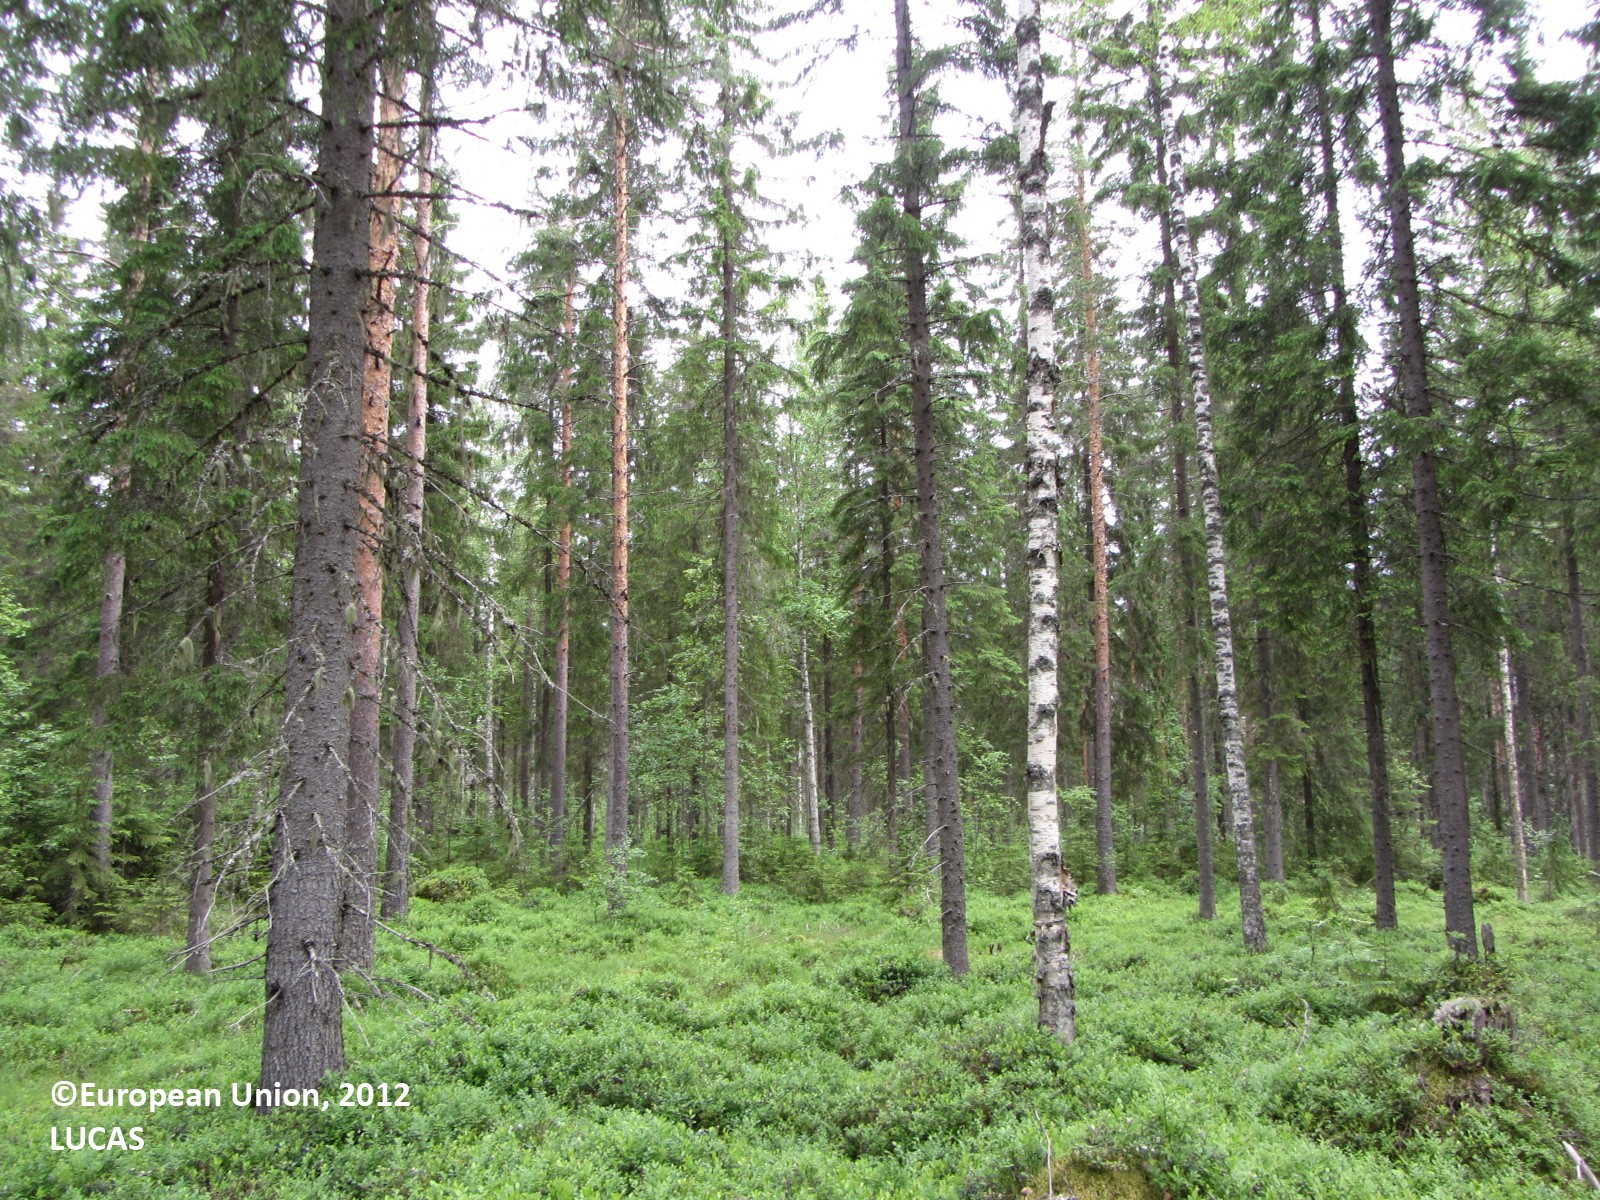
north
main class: Woodland
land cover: Spruce dominated mixed woodland
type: boreal forest
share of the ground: 50 - 75 %
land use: Forestry
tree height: > 5 m
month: June
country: FI
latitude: 62.5864
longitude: 25.2320
